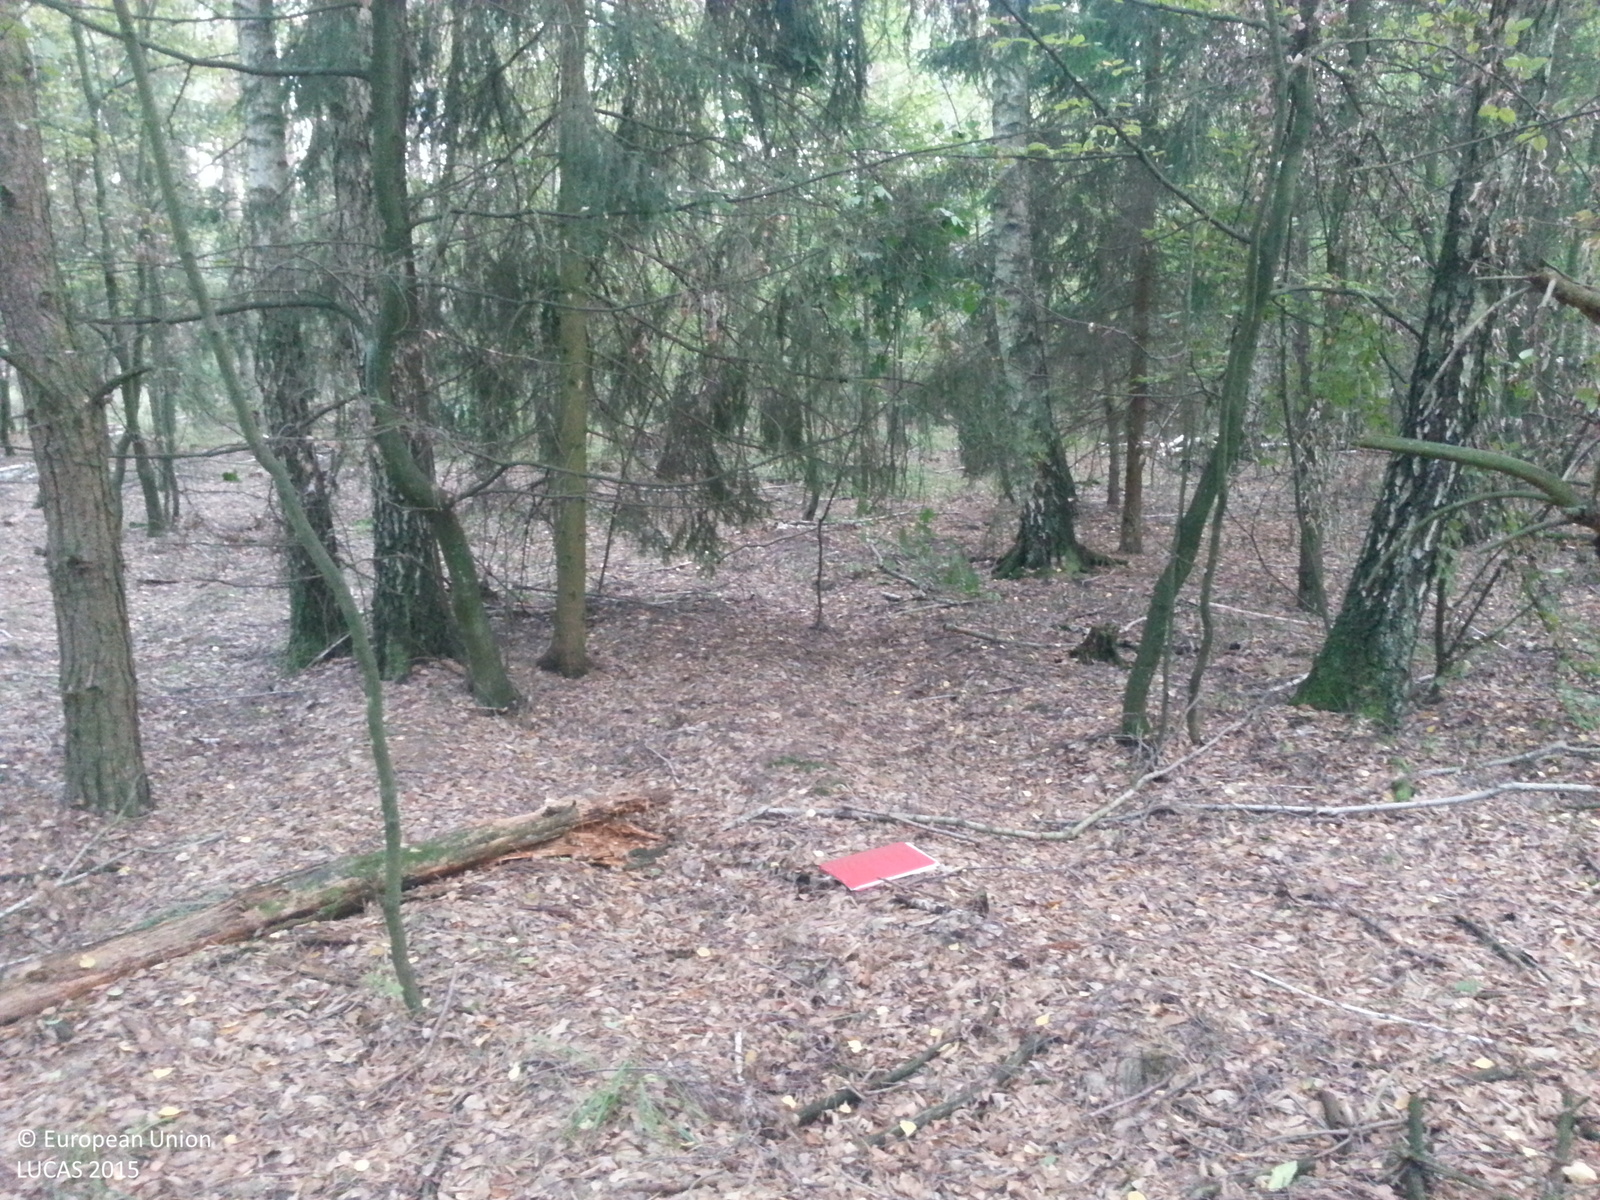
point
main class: Woodland
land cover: Other mixed woodland
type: hemiboreal forest and nemoral coniferous forest and mixed broadleaved-coniferous forest
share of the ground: > 75 %
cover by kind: broadleaved forest trees 45 %, coniferous forest trees 30 %, unconsolidated bare surface 20 %, herbaceous plants 5 %
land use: Forestry
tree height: > 5 m
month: September
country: PL
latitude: 53.1804
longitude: 19.1664
